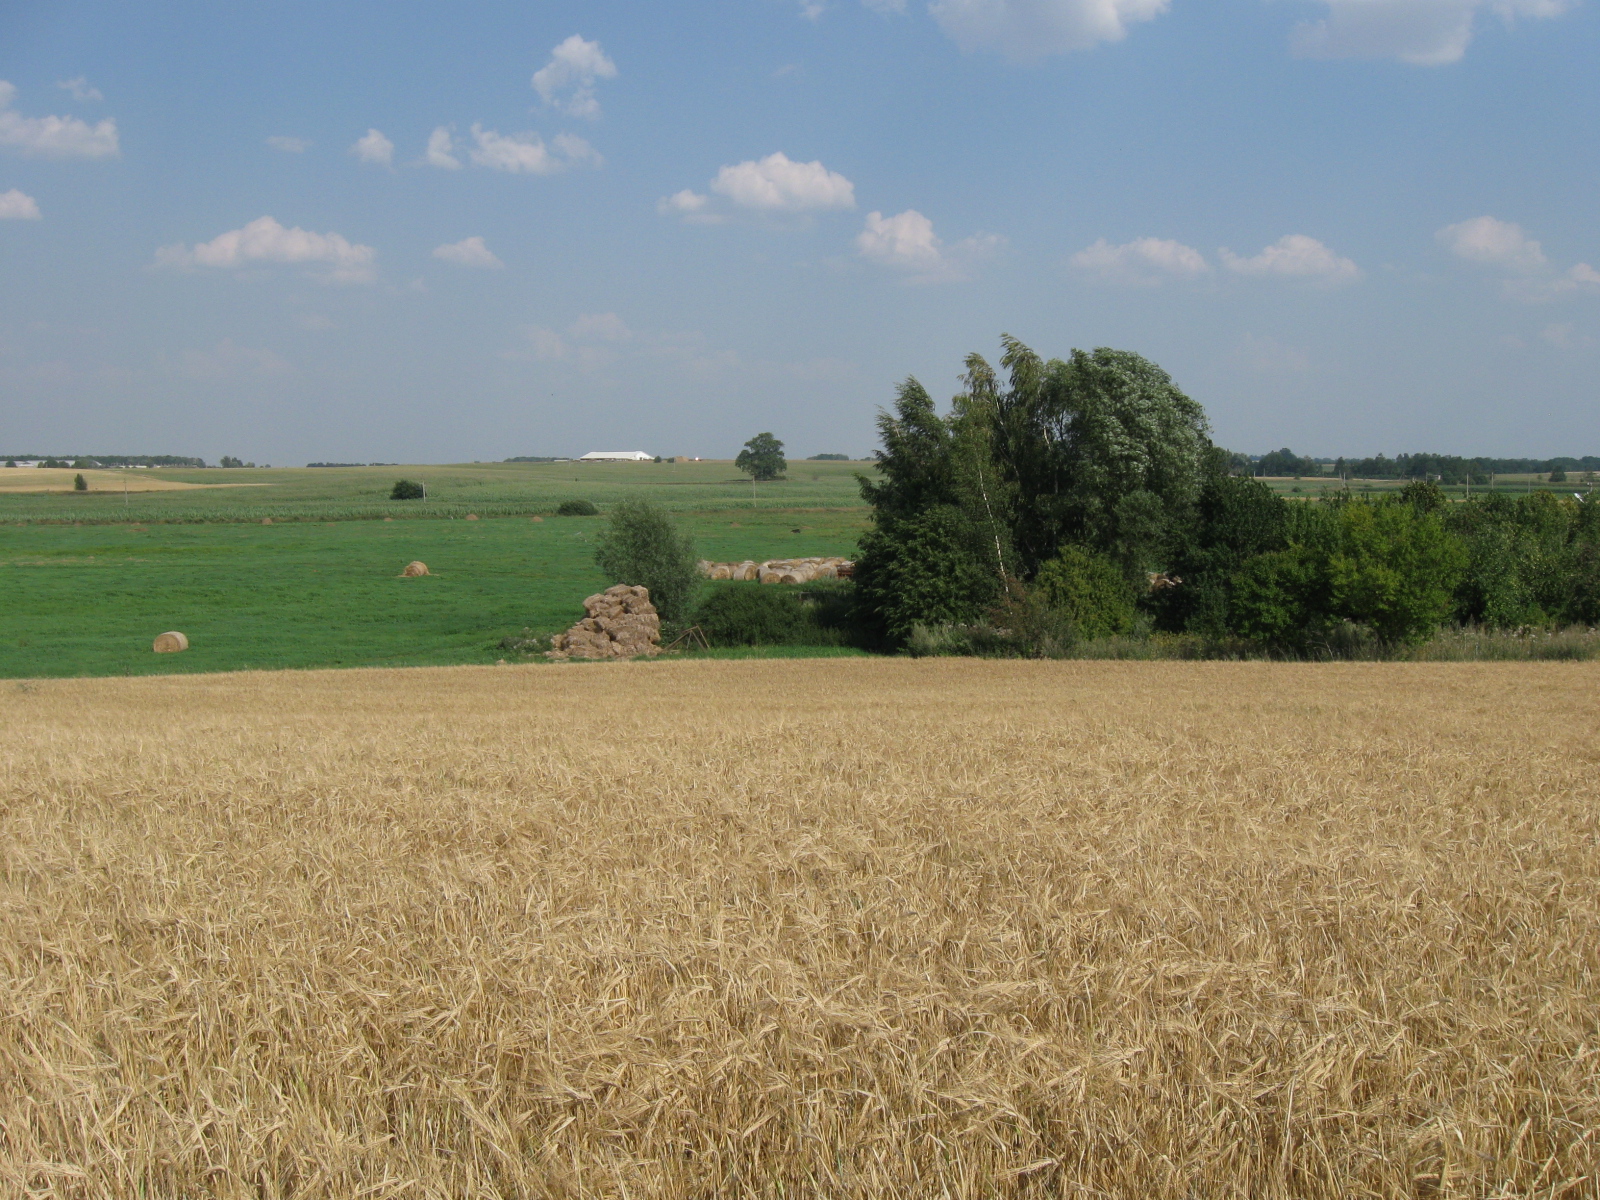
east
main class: Cropland
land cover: Barley
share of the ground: > 75 %
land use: Agriculture (excluding fallow land and kitchen gardens)
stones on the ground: < 10 %
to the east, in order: Barley; Grassland without tree/shrub cover; Broadleaved woodland; Artificial constructions in urban areas; Grassland without tree/shrub cover; Tracks; Grassland without tree/shrub cover
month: August
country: LT
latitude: 54.4198
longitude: 23.2539
